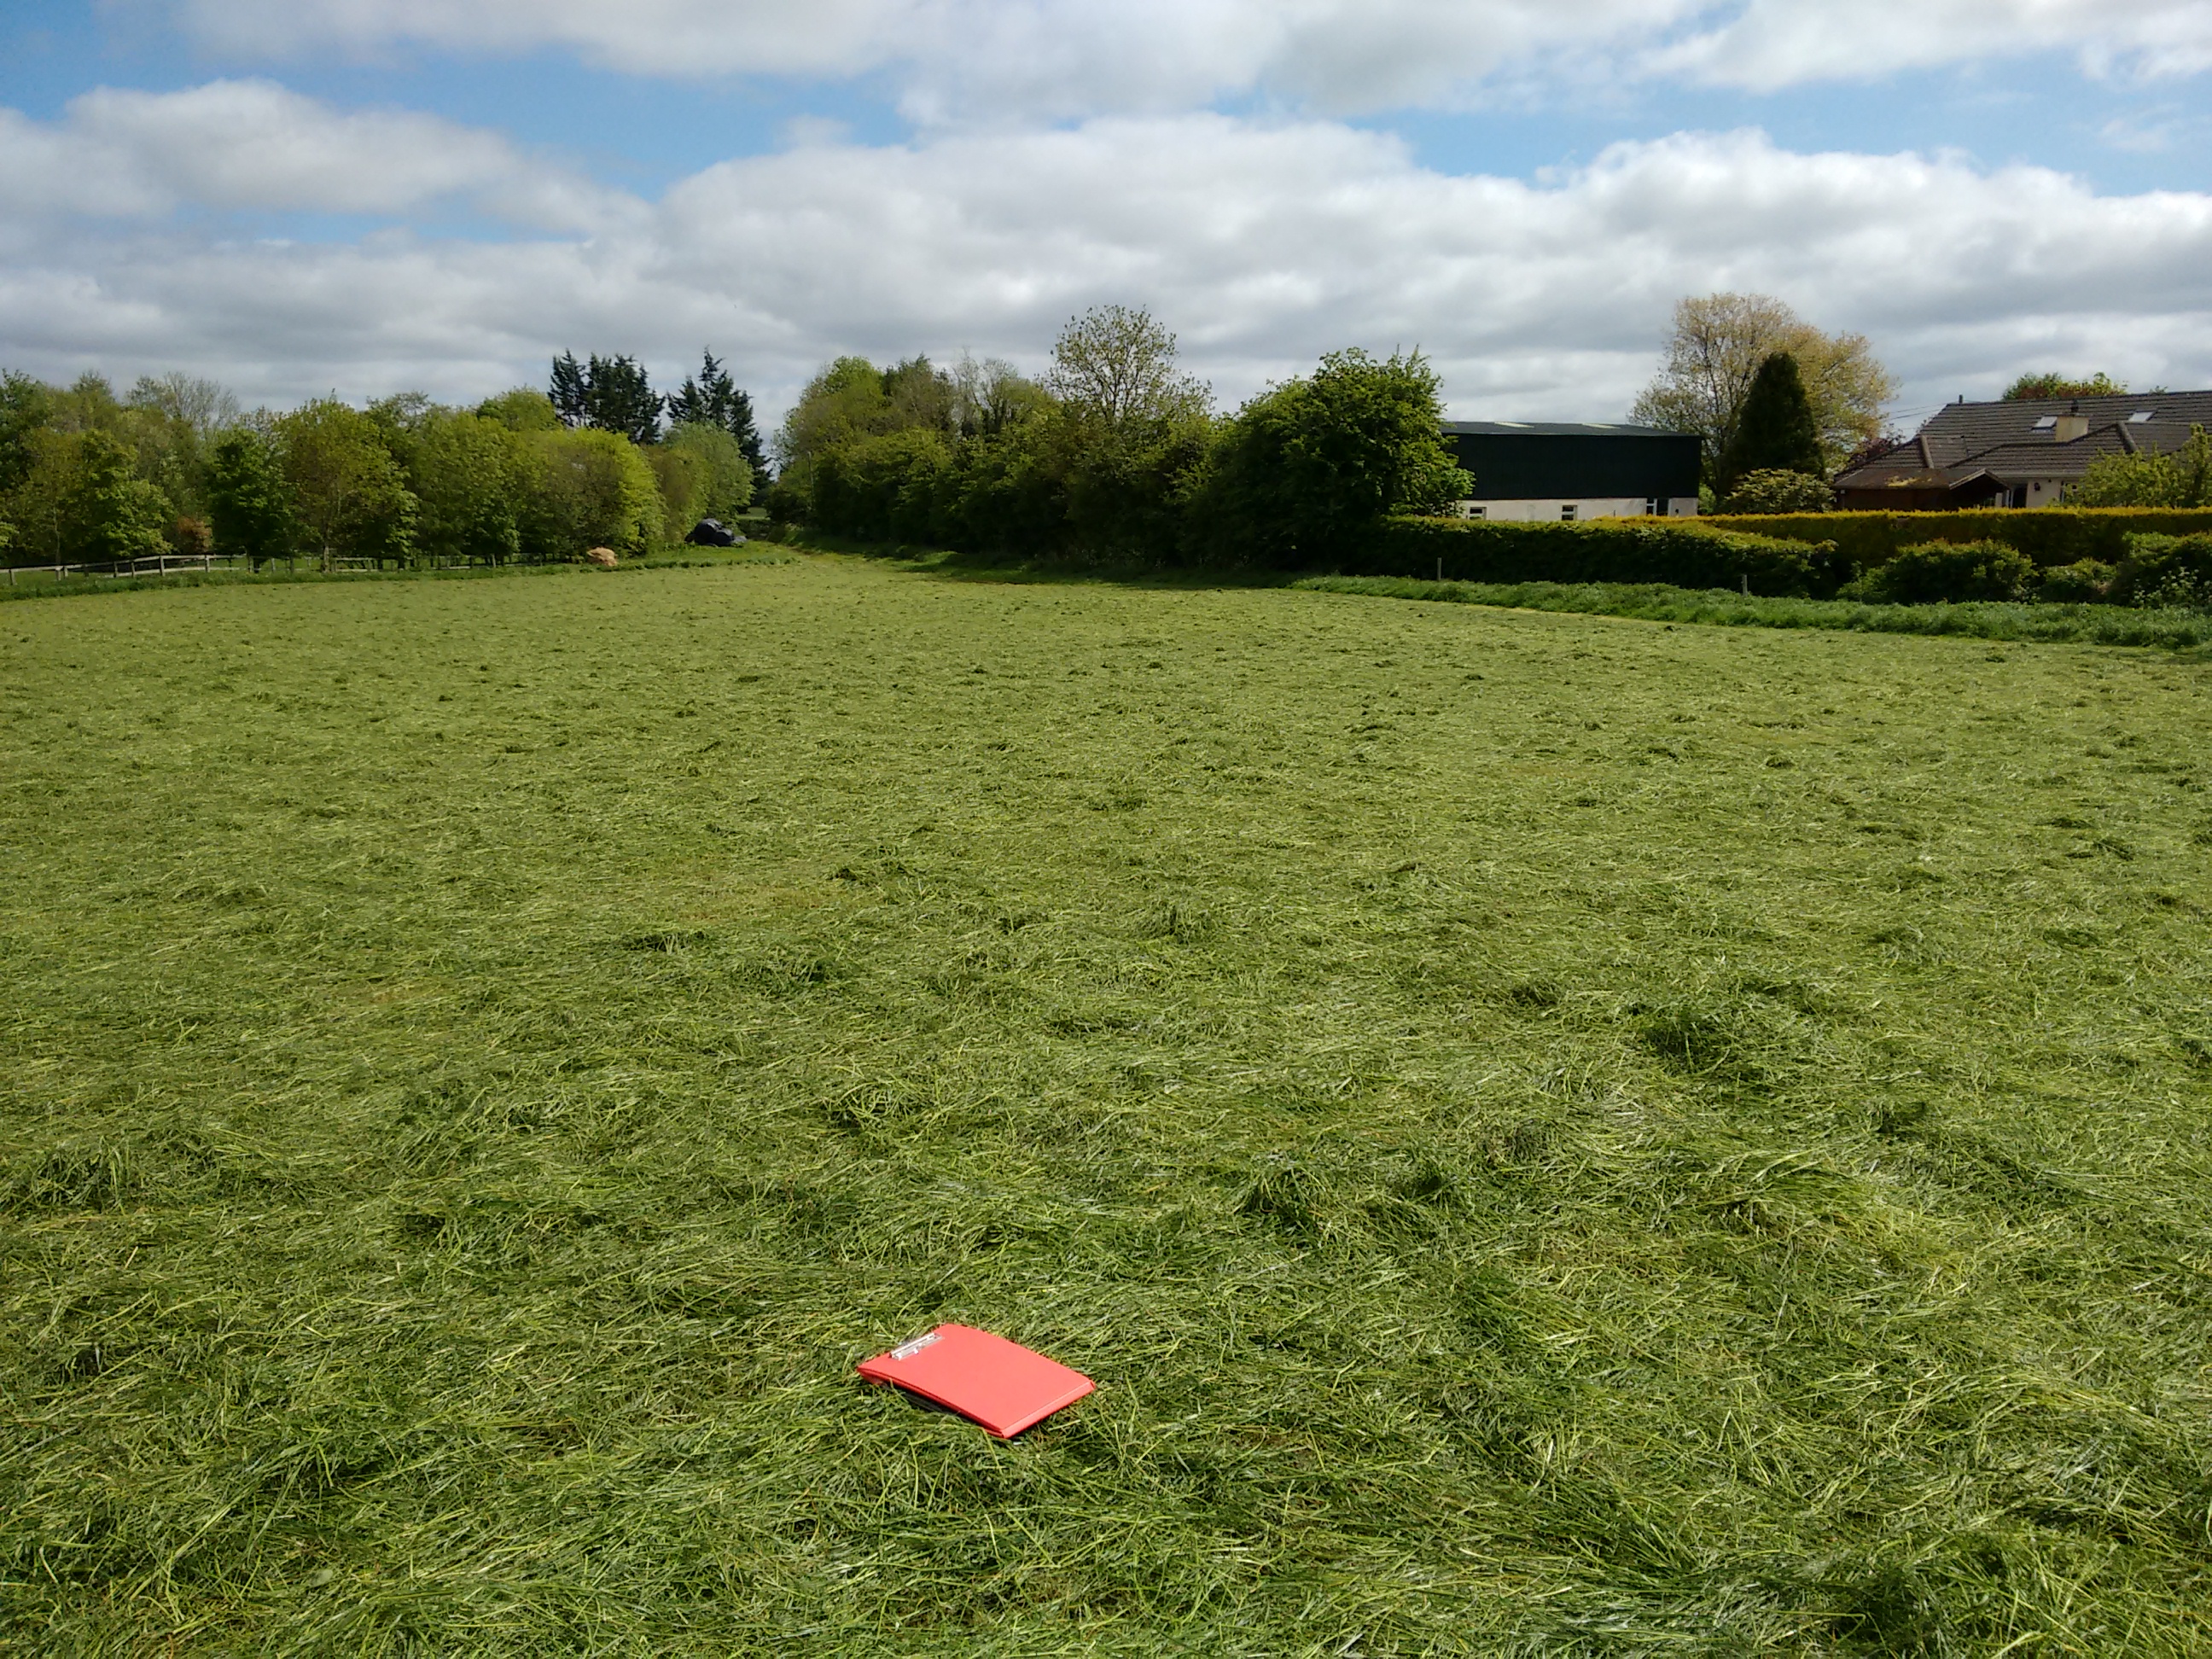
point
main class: Cropland
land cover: Barley
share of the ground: > 75 %
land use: Agriculture (excluding fallow land and kitchen gardens)
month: May
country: IE
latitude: 53.4938
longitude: -6.6048
